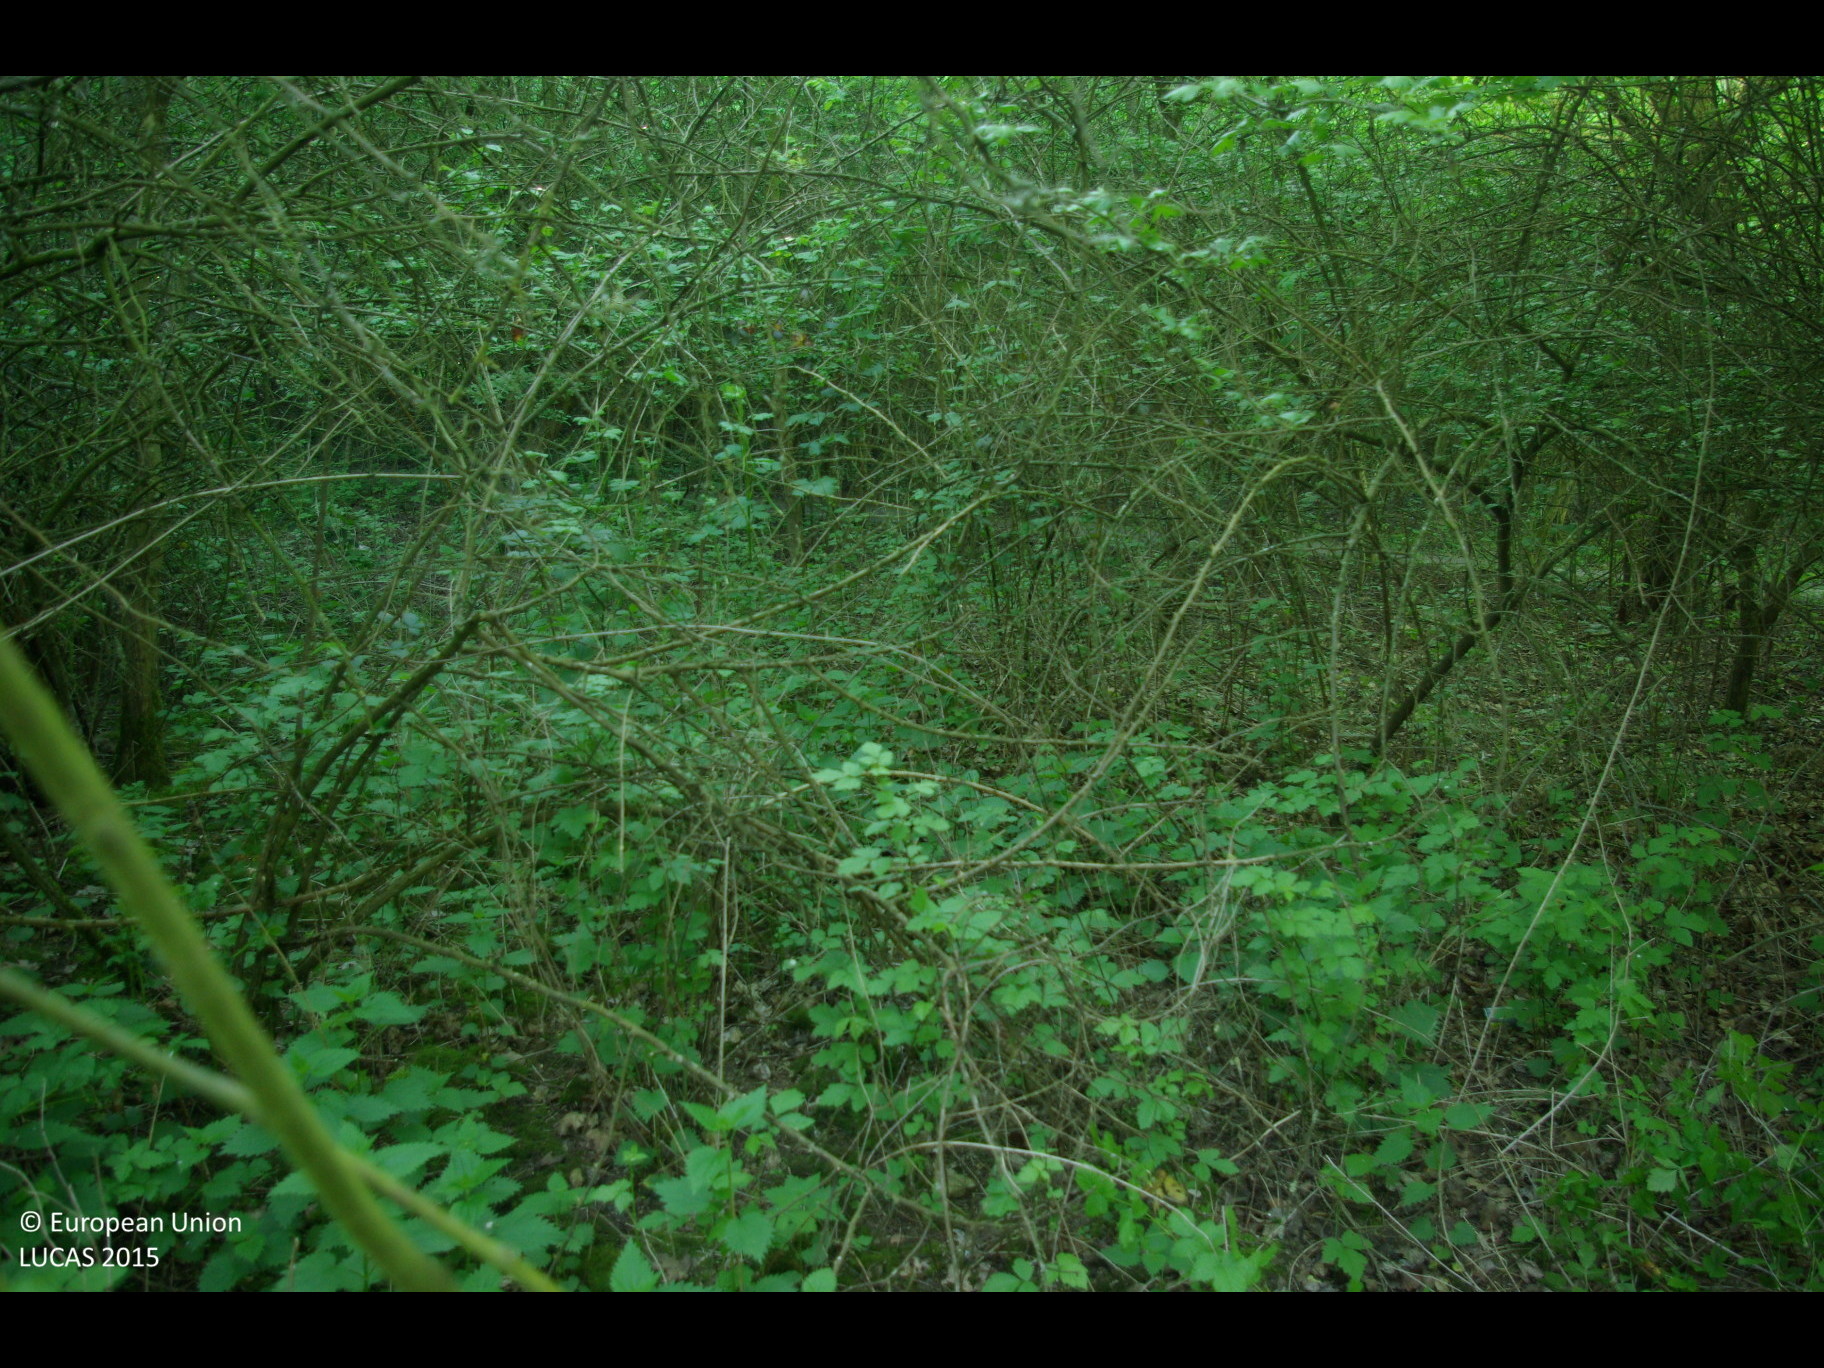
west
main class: Shrubland
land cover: Shrubland with sparse tree cover
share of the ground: > 75 %
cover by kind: shrubs 80 %, herbaceous plants 10 %, broadleaved forest trees 5 %, unconsolidated bare surface 5 %
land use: Semi-natural and natural areas not in use
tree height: < 5 m
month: May
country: DE
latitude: 54.3684
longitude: 10.9999
